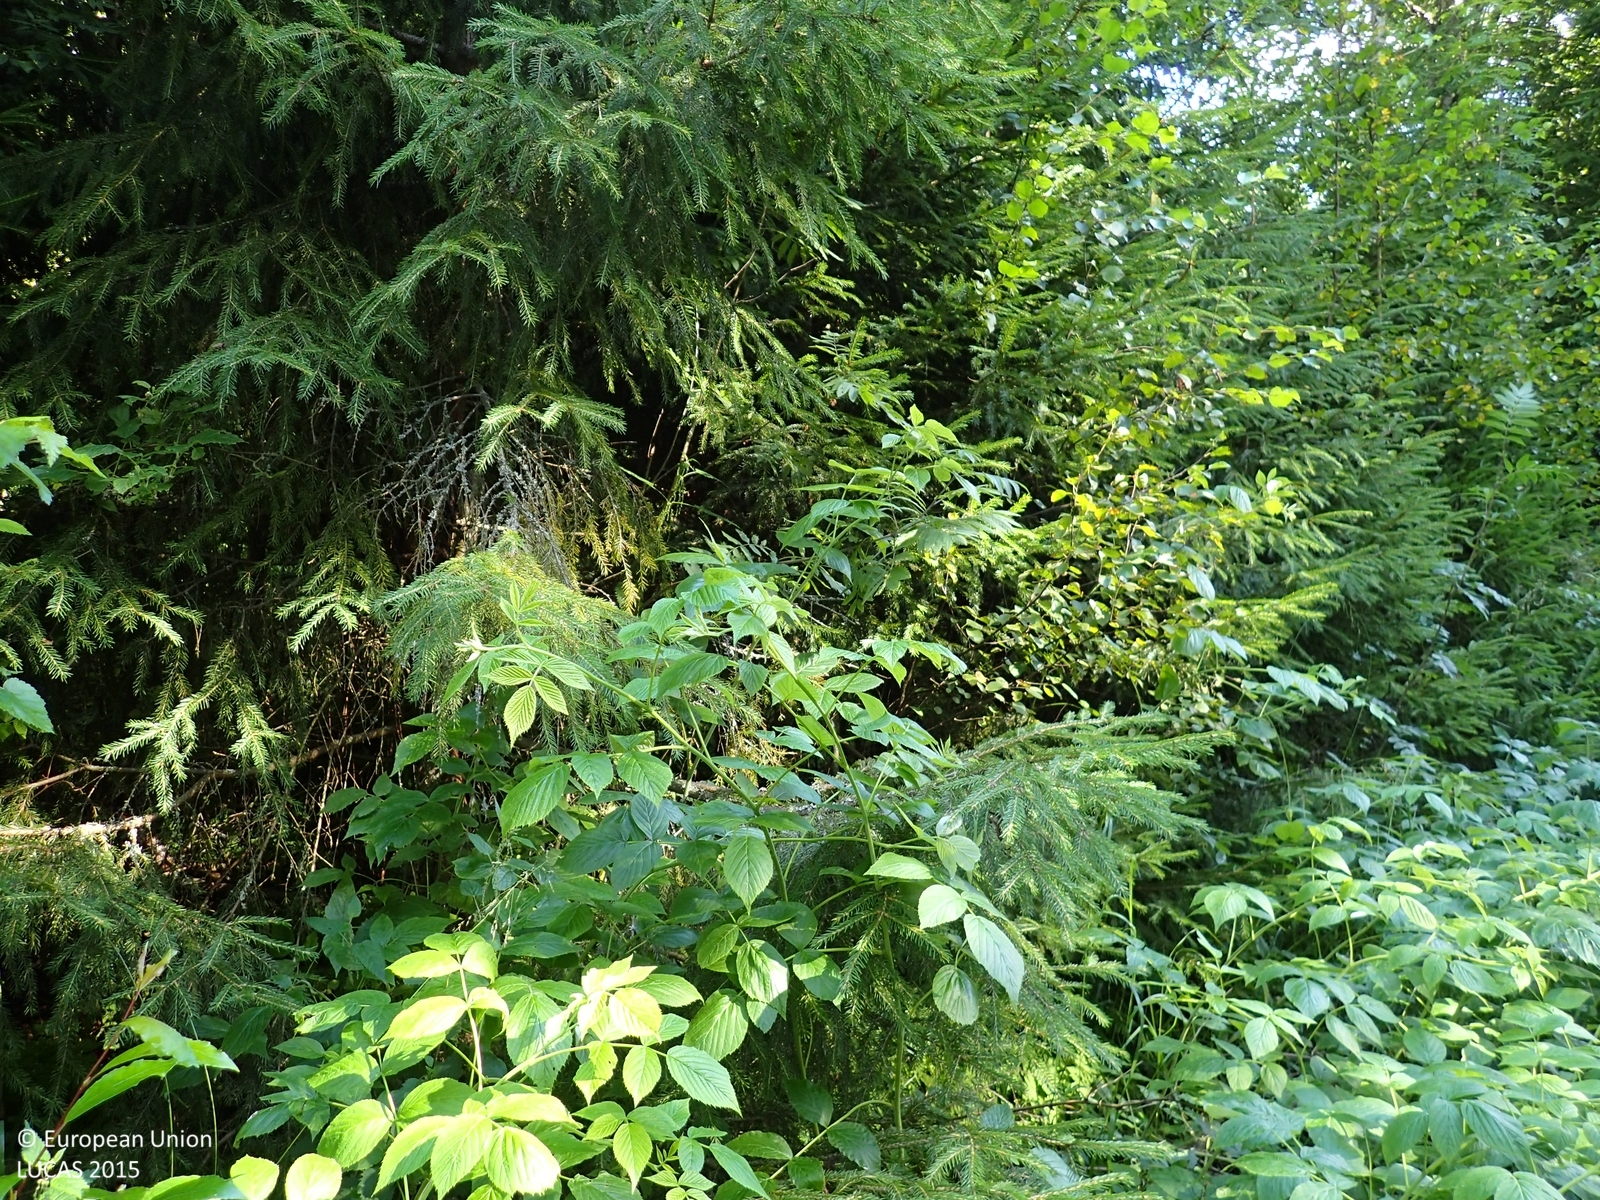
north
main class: Woodland
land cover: Broadleaved woodland
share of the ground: 25 - 50 %
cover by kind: herbaceous plants 75 %, broadleaved forest trees 25 %
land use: Forestry
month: August
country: FI
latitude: 62.9676
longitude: 21.8172
